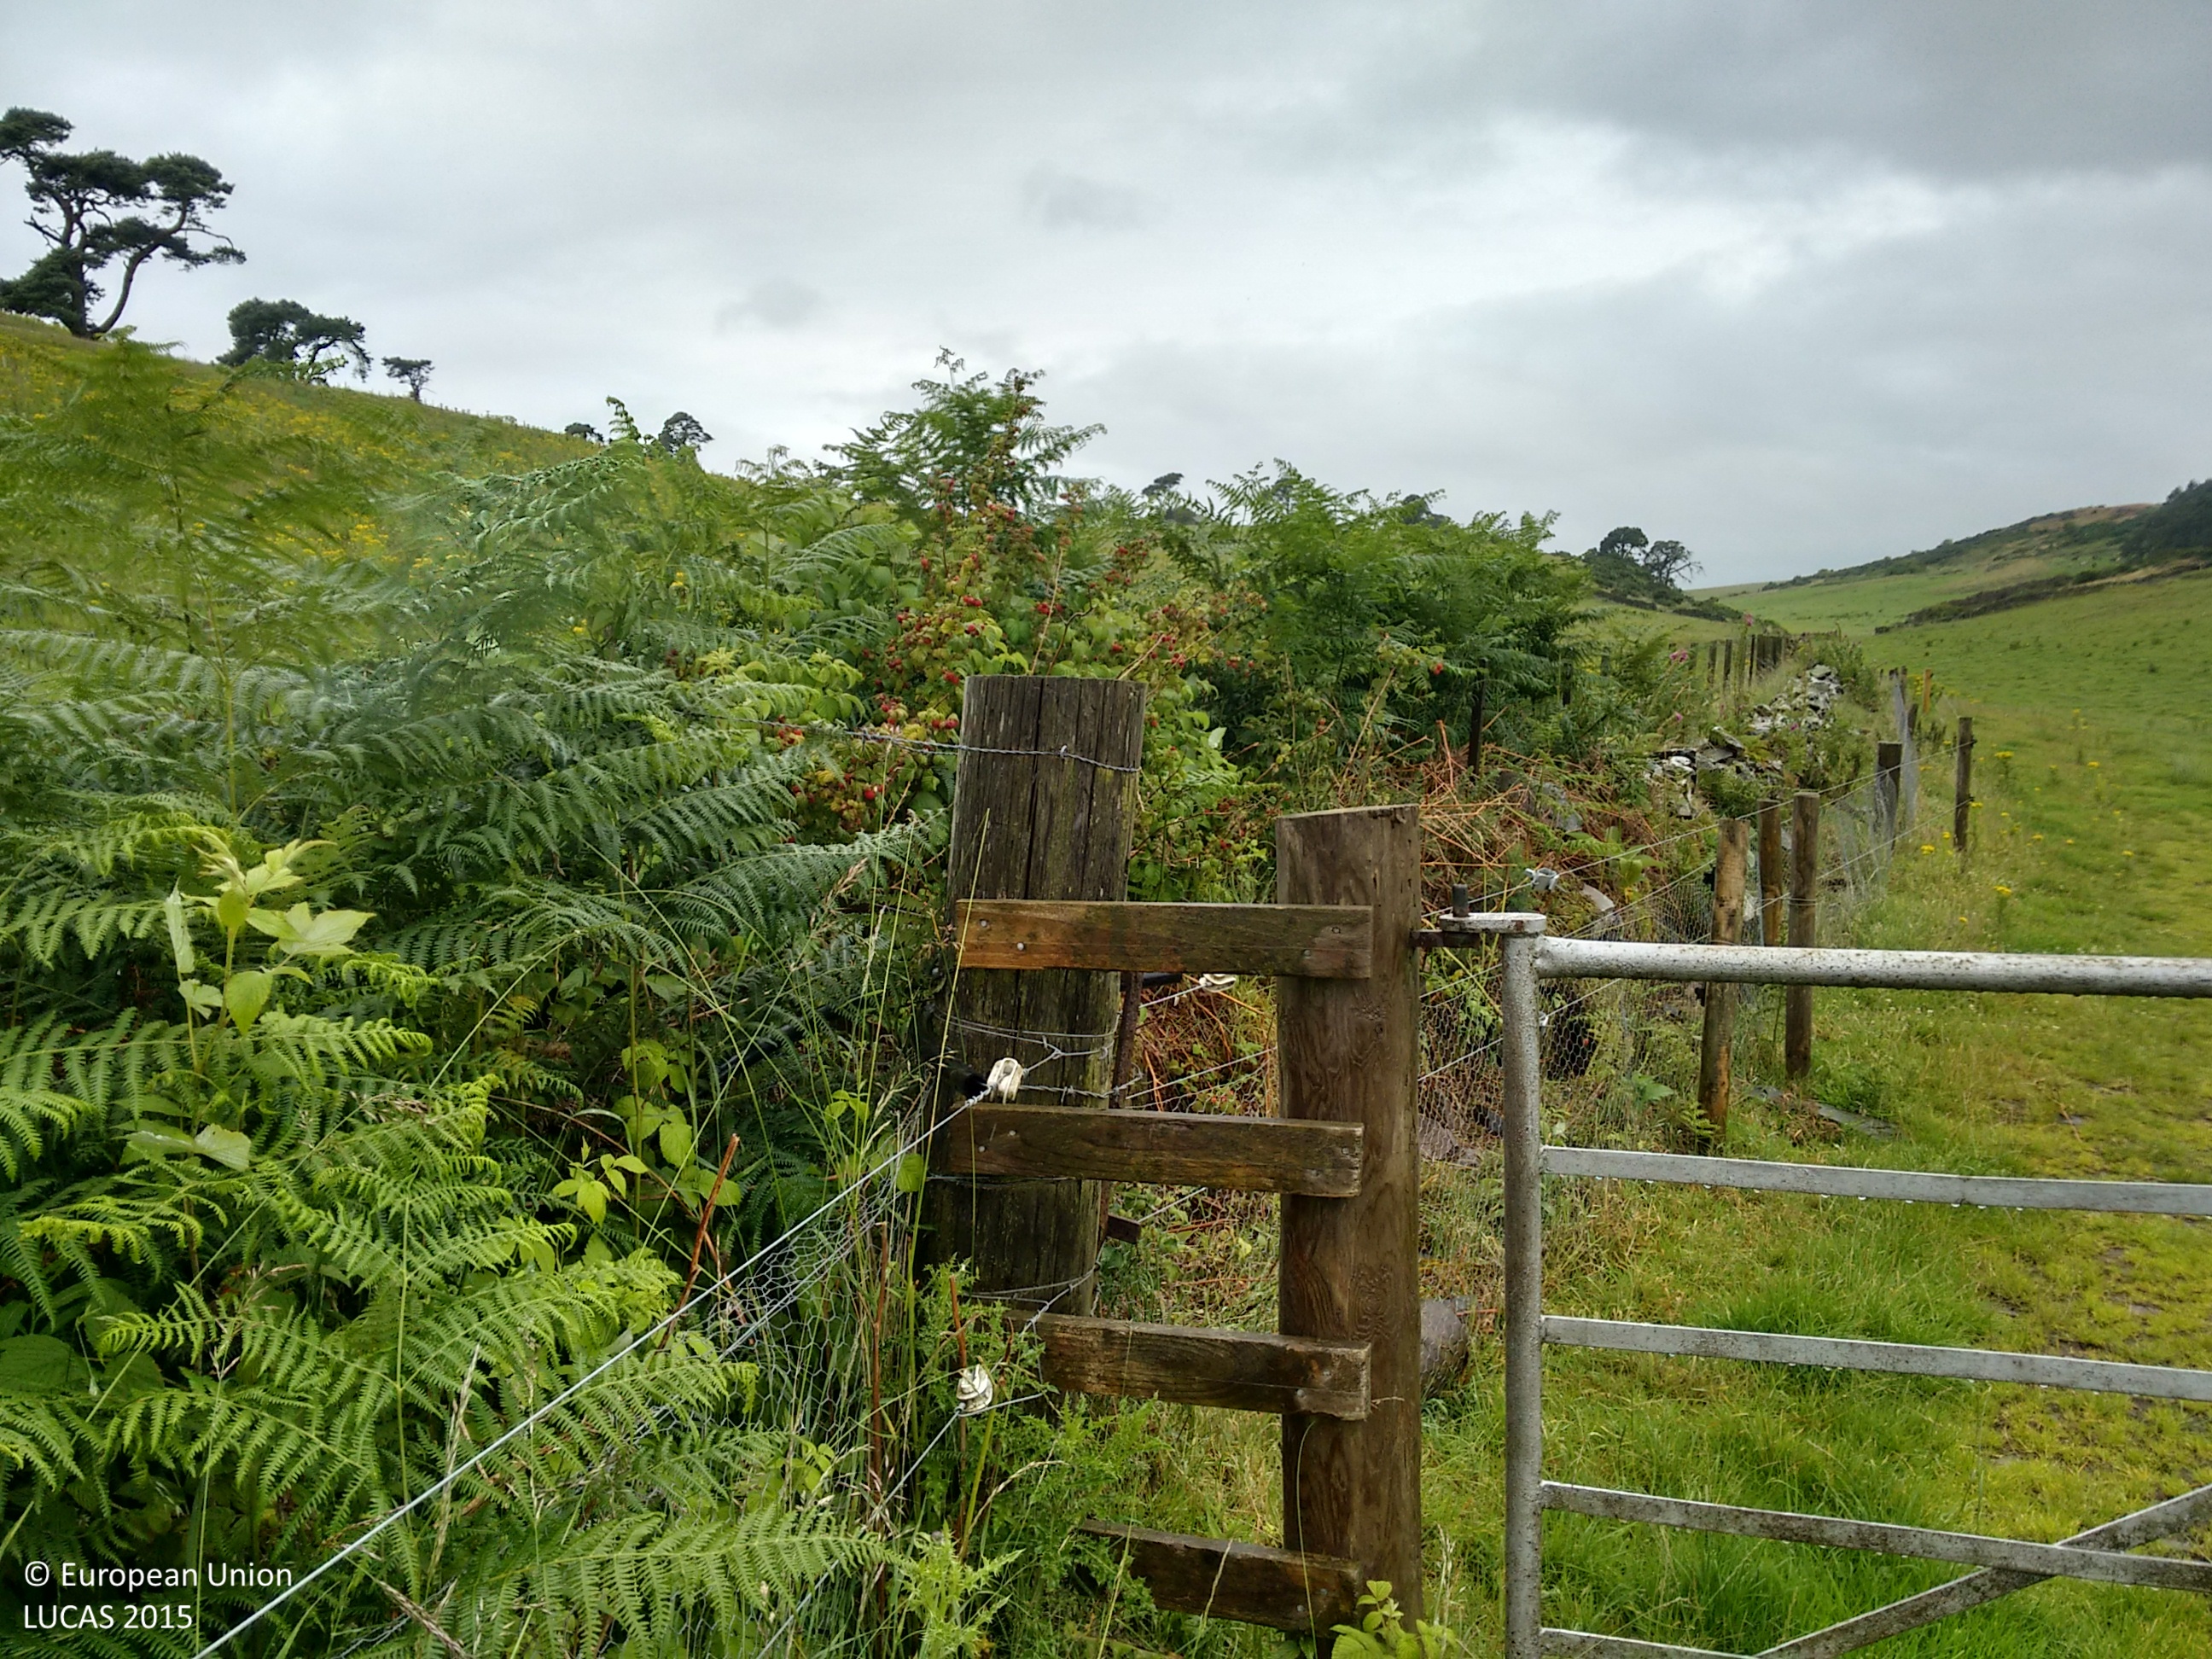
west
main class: Grassland
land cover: Grassland without tree/shrub cover
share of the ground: > 75 %
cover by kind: herbaceous plants 100 %
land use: Agriculture (excluding fallow land and kitchen gardens)
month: July
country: GB
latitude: 56.3698
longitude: -3.1010
